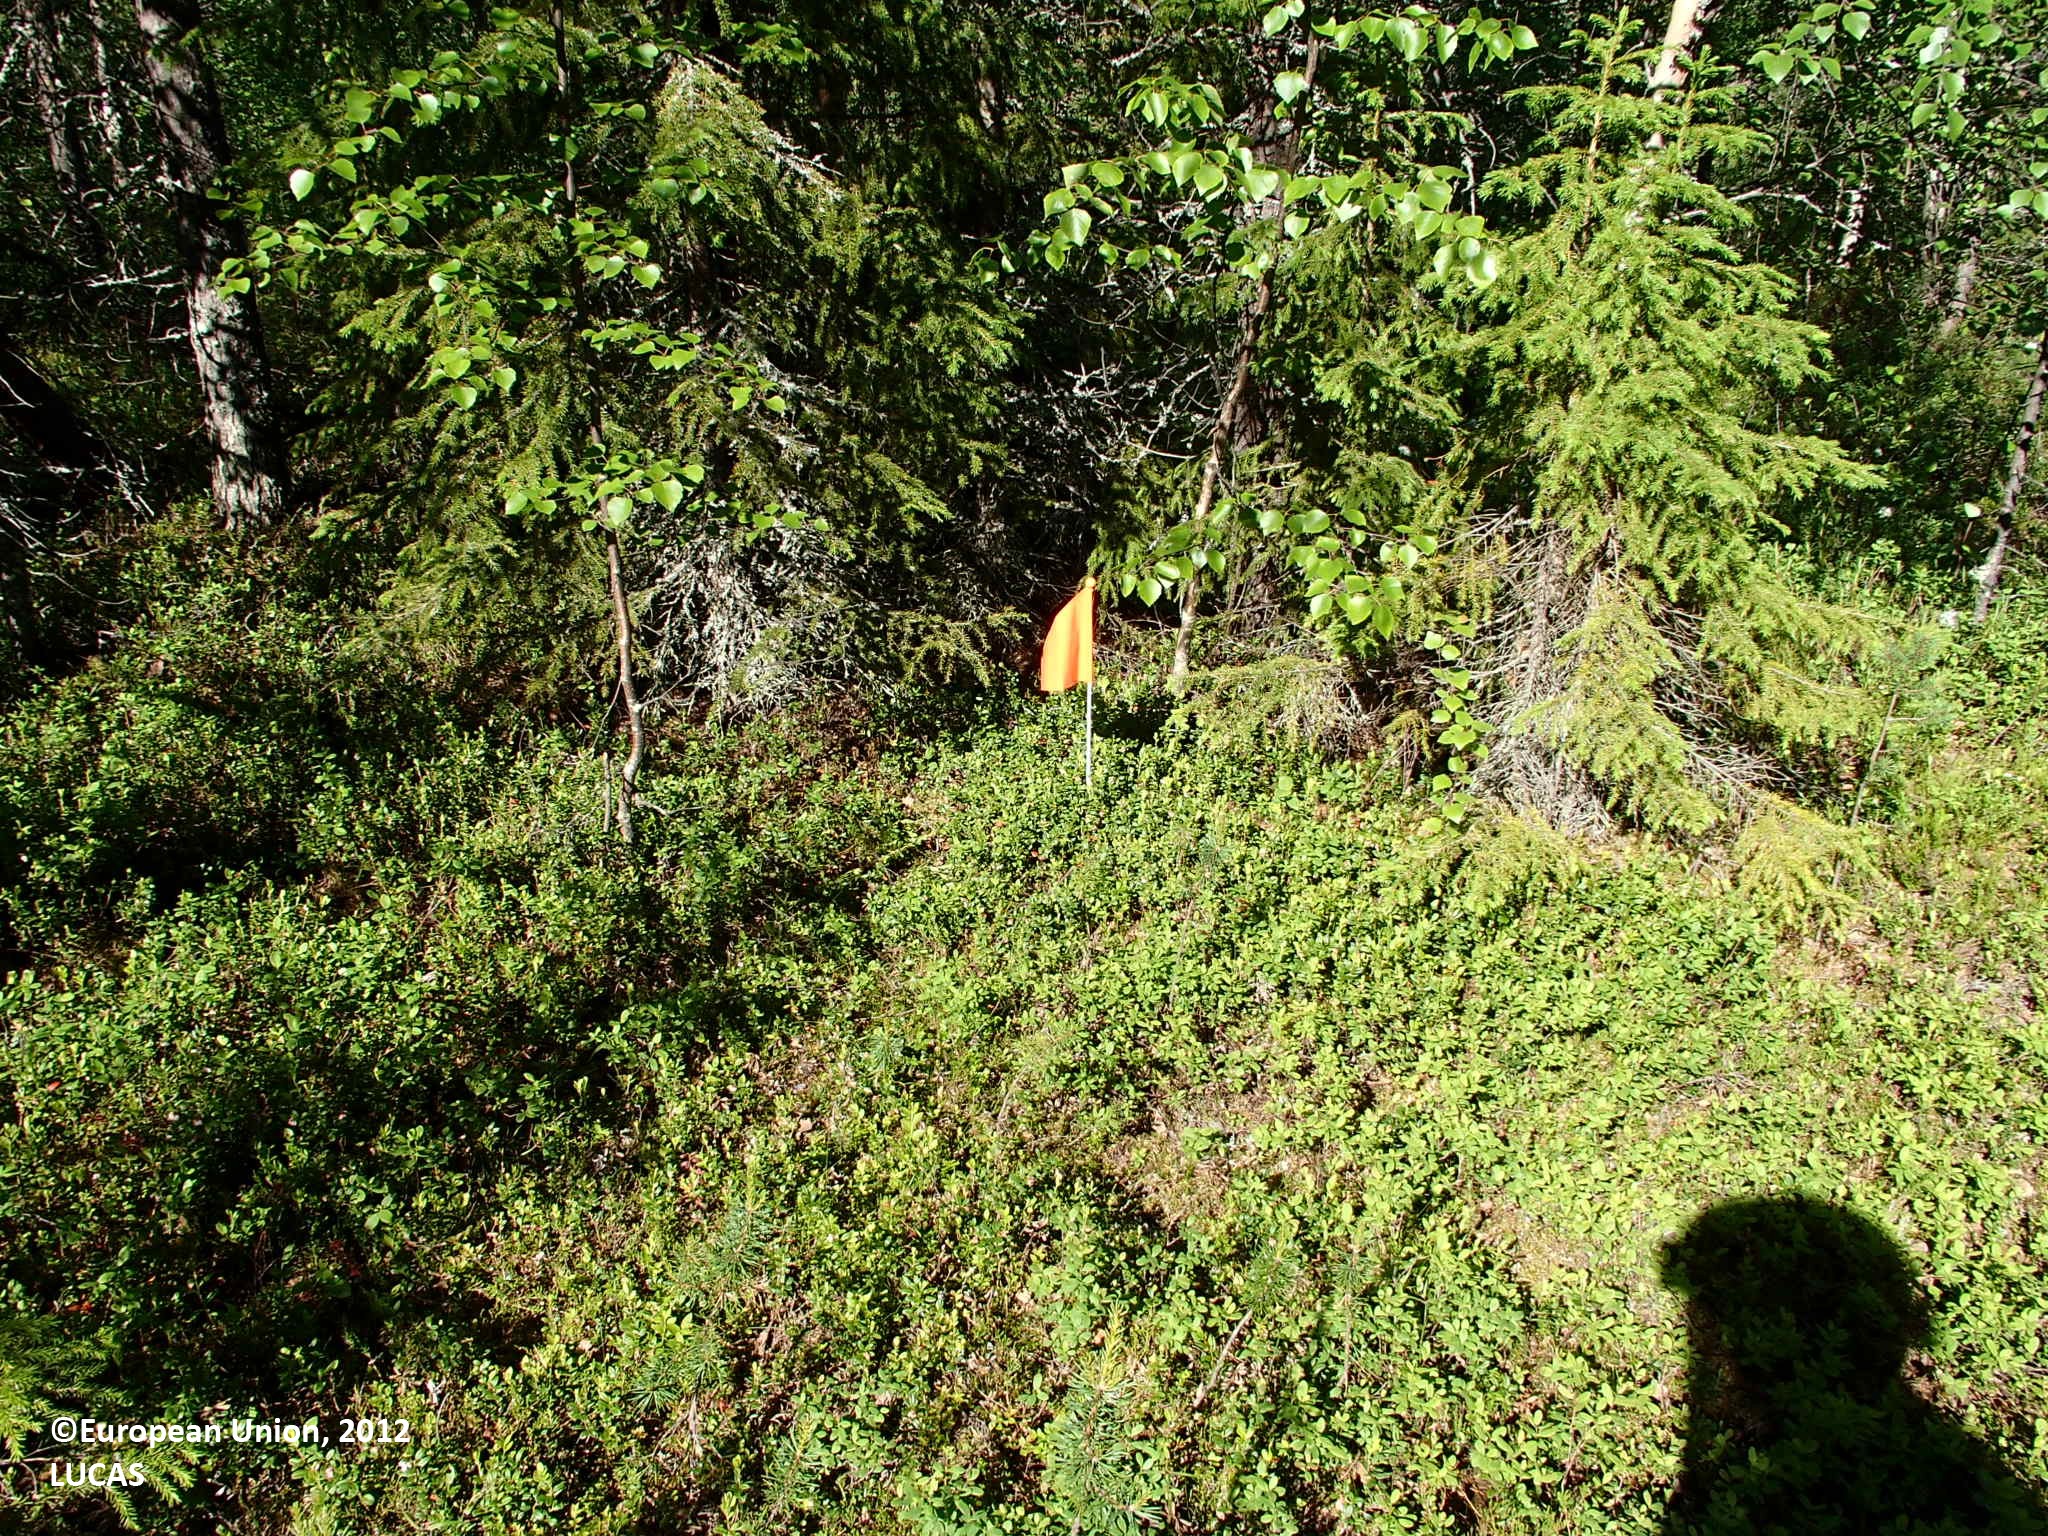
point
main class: Woodland
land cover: Other mixed woodland
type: boreal forest
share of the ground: > 75 %
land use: Forestry
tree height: > 5 m
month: July
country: FI
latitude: 67.2045
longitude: 27.8054
